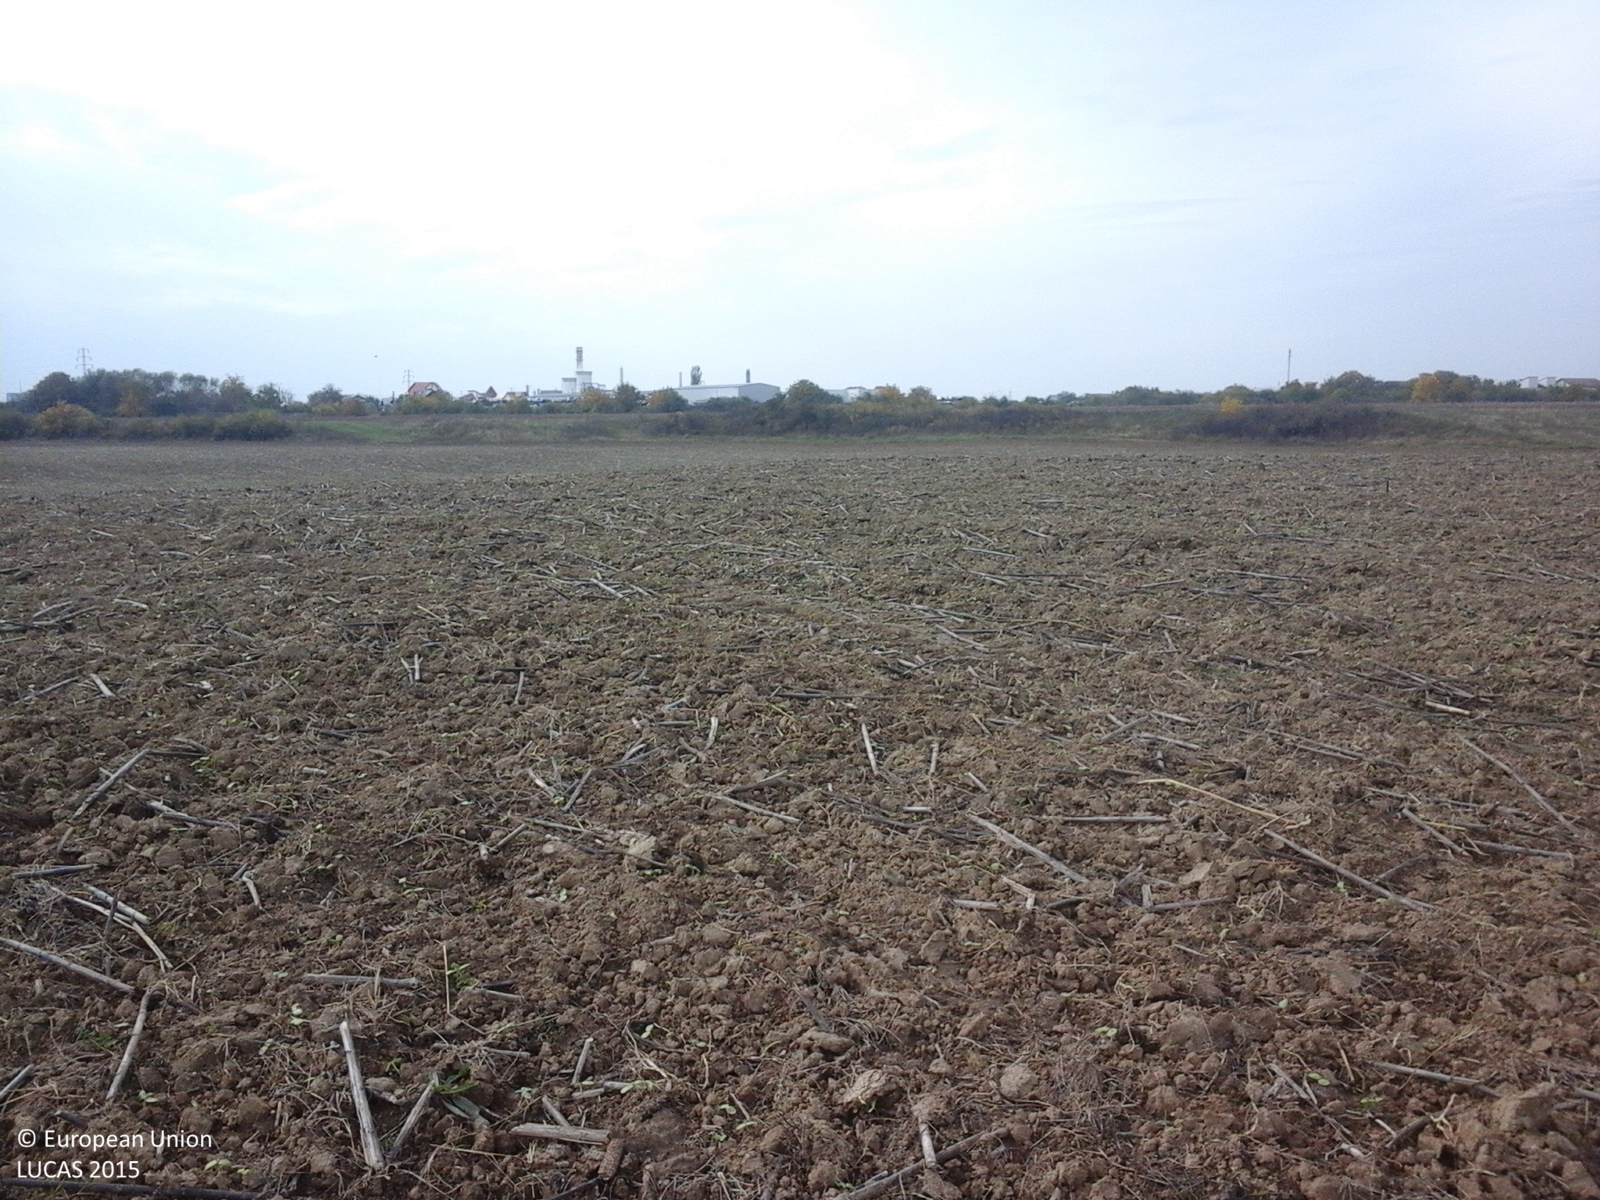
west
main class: Cropland
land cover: Sunflower
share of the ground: 10 - 25 %
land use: Agriculture (excluding fallow land and kitchen gardens)
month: October
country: RO
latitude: 44.9647
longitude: 26.0453
